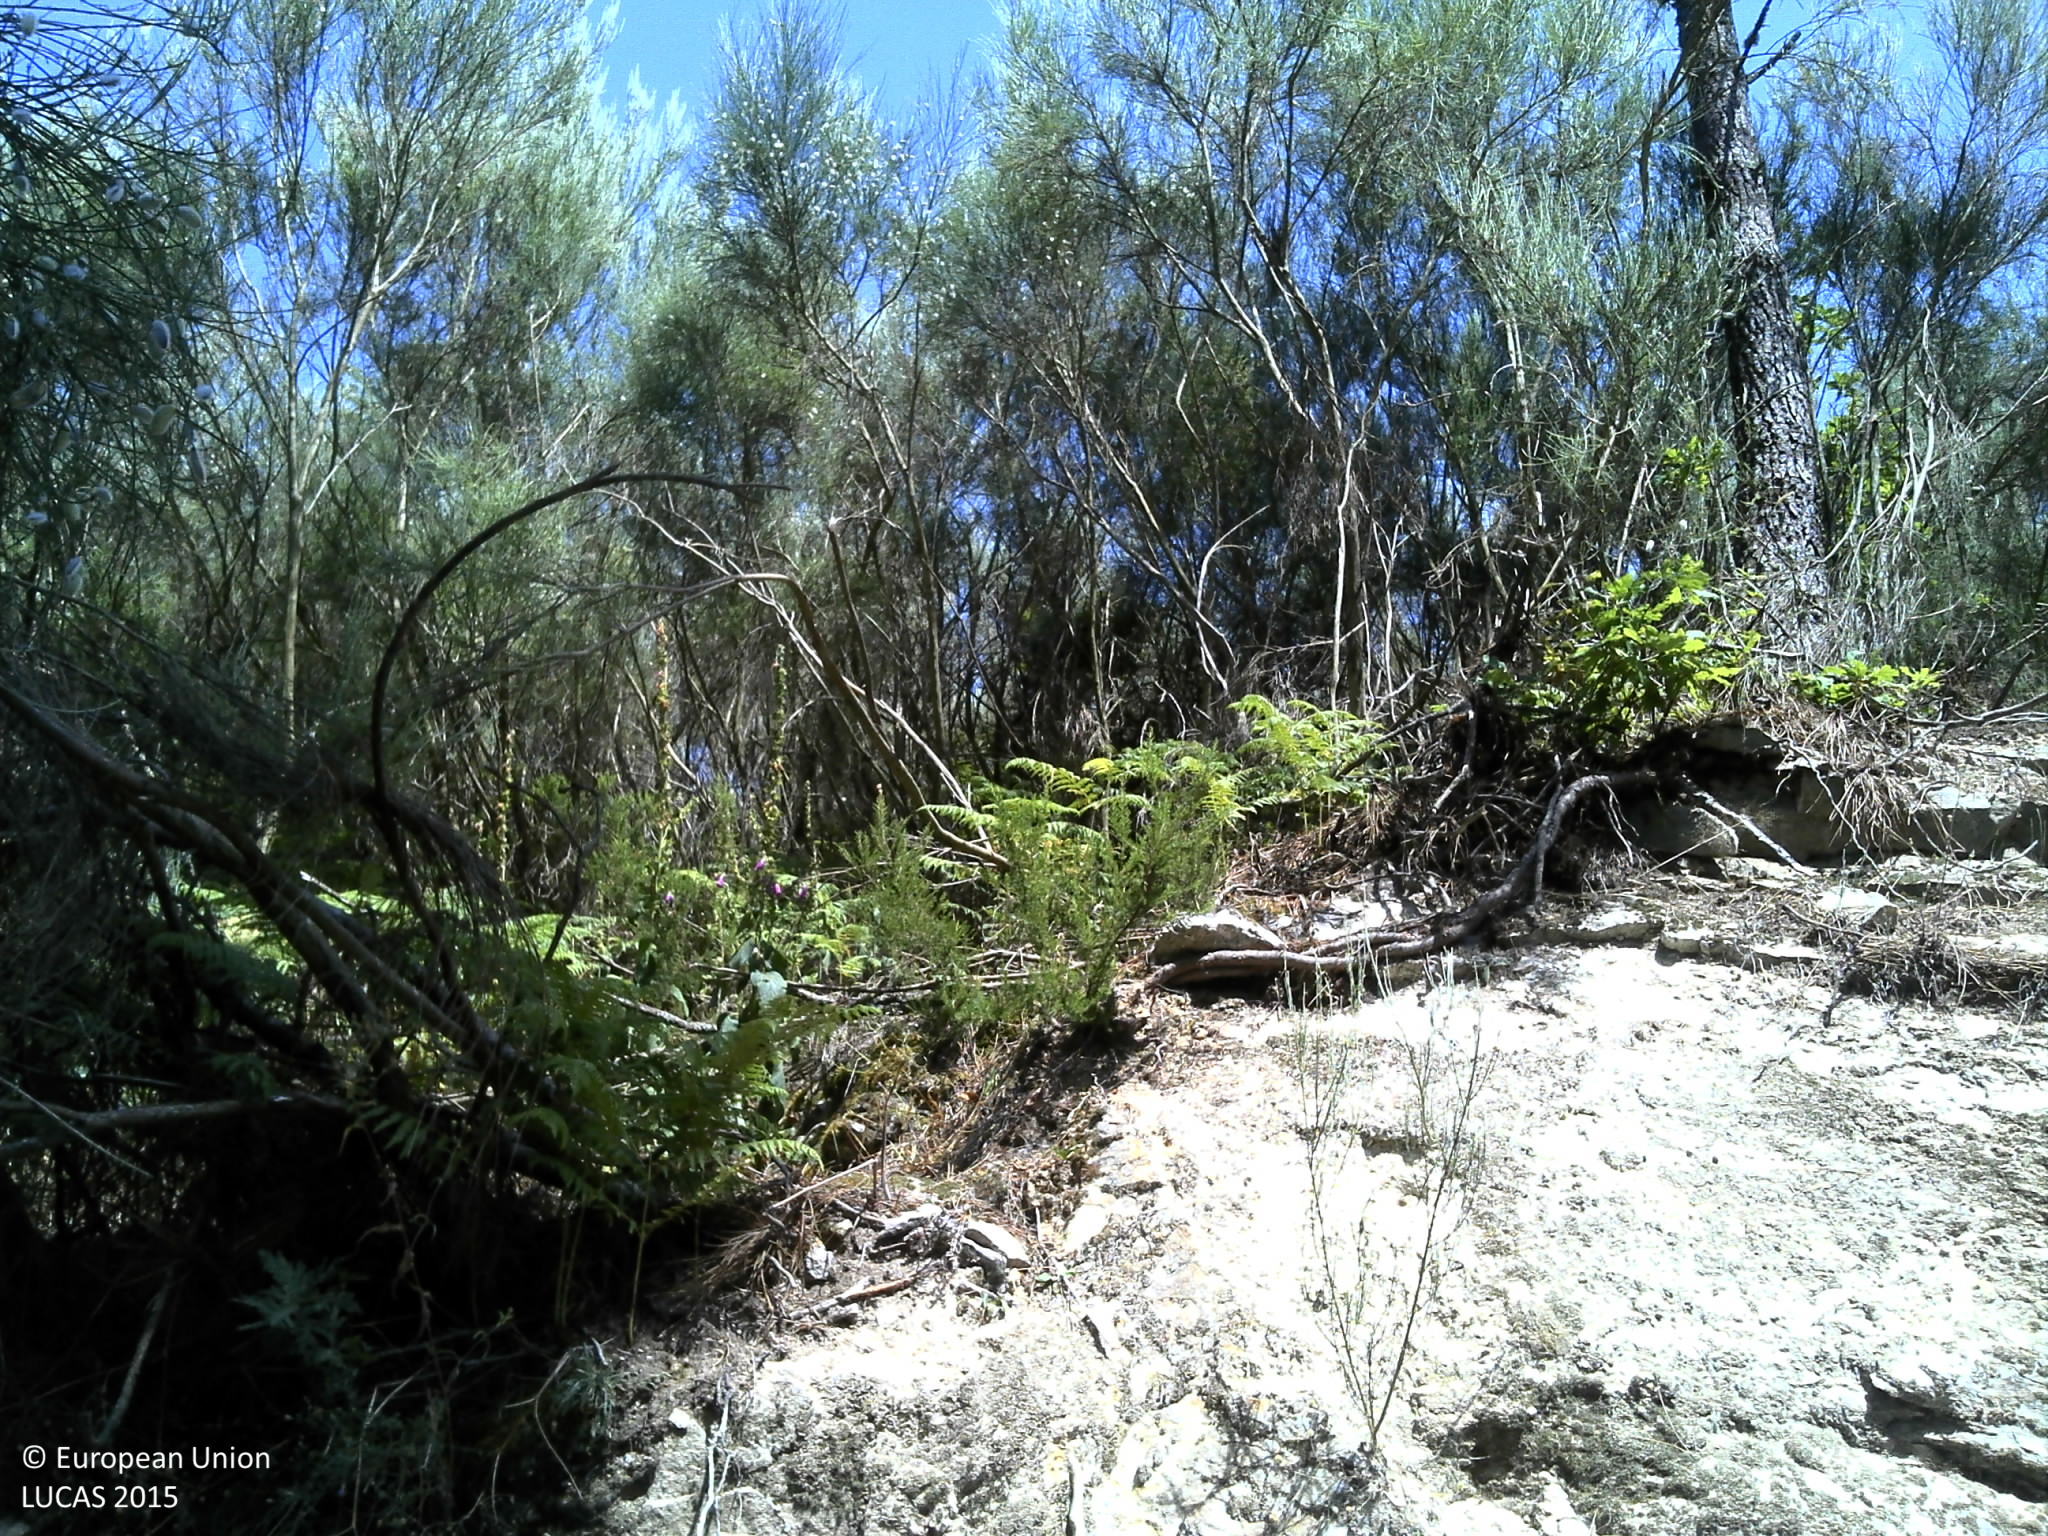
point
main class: Shrubland
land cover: Shrubland with sparse tree cover
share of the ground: > 75 %
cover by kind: shrubs 70 %, unconsolidated bare surface 25 %, coniferous forest trees 5 %
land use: Semi-natural and natural areas not in use
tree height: > 5 m
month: July
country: PT
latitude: 40.9579
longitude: -7.8664
